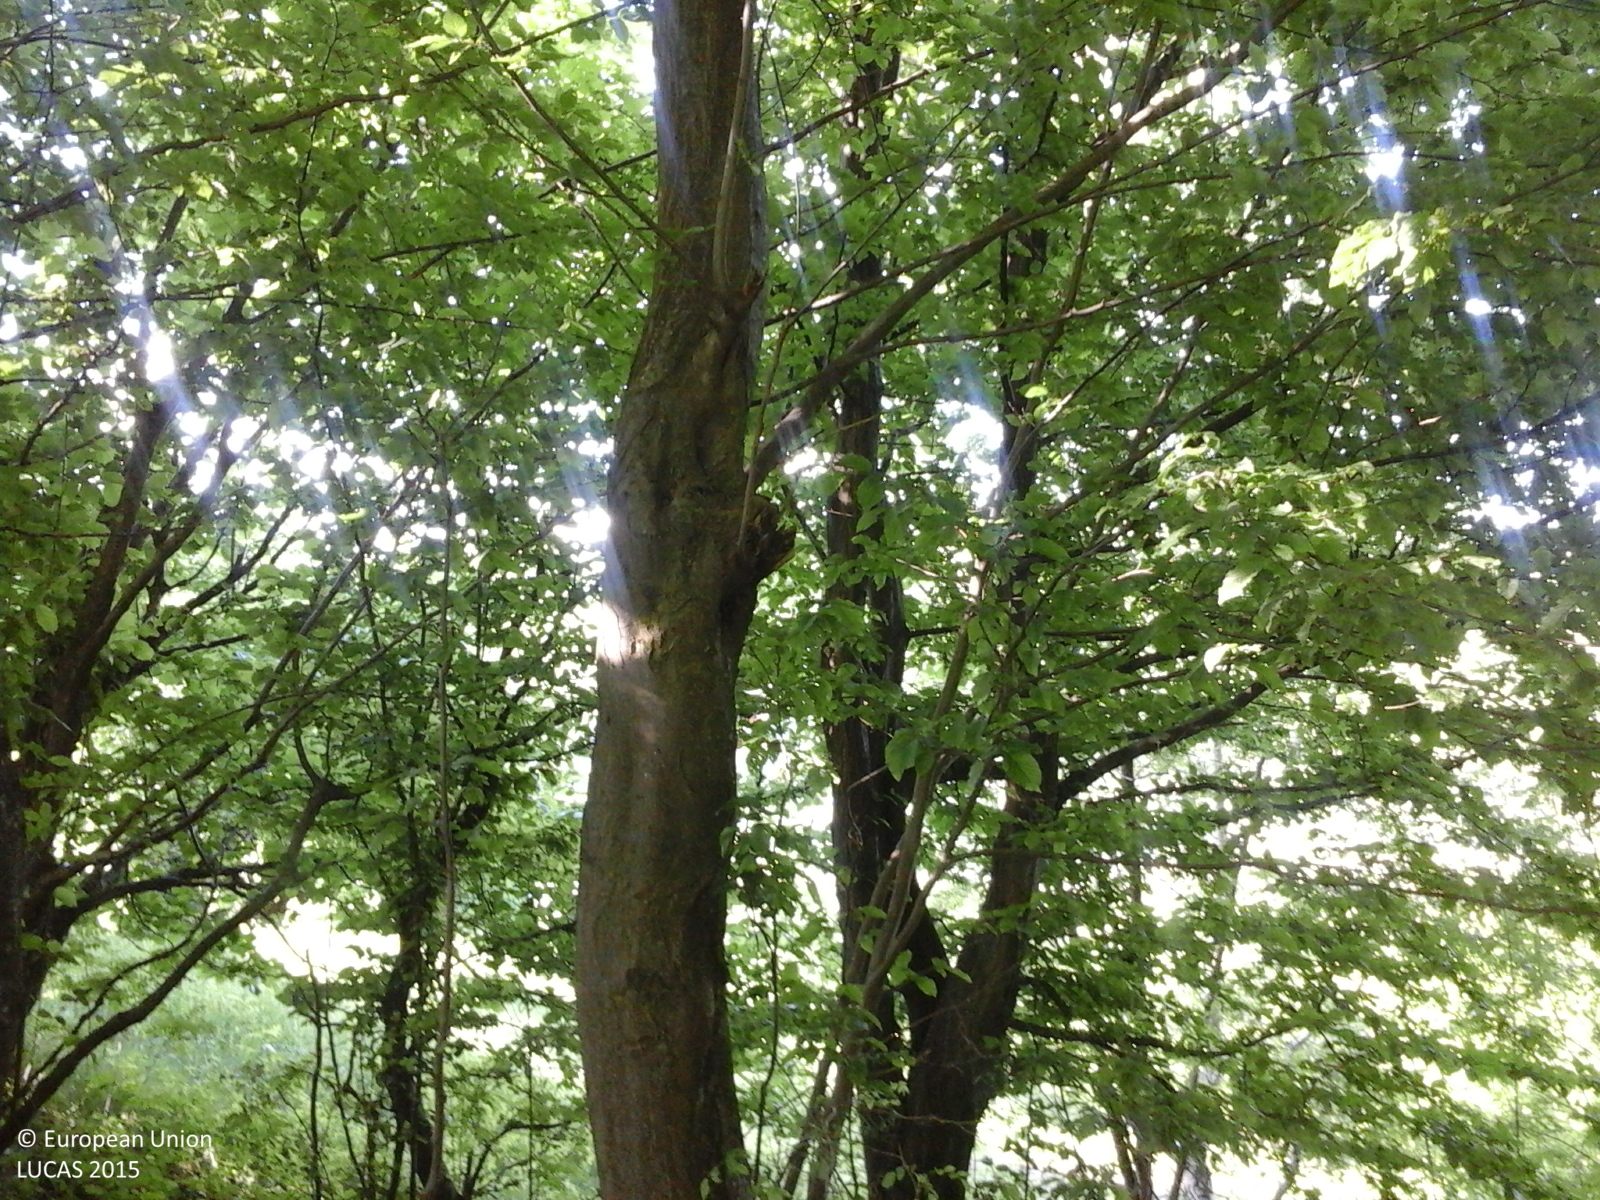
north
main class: Woodland
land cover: Broadleaved woodland
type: beech forest
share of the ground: > 75 %
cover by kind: broadleaved forest trees 100 %
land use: Forestry
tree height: > 5 m
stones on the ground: < 10 %
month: May
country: RO
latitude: 45.3079
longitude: 26.1992
